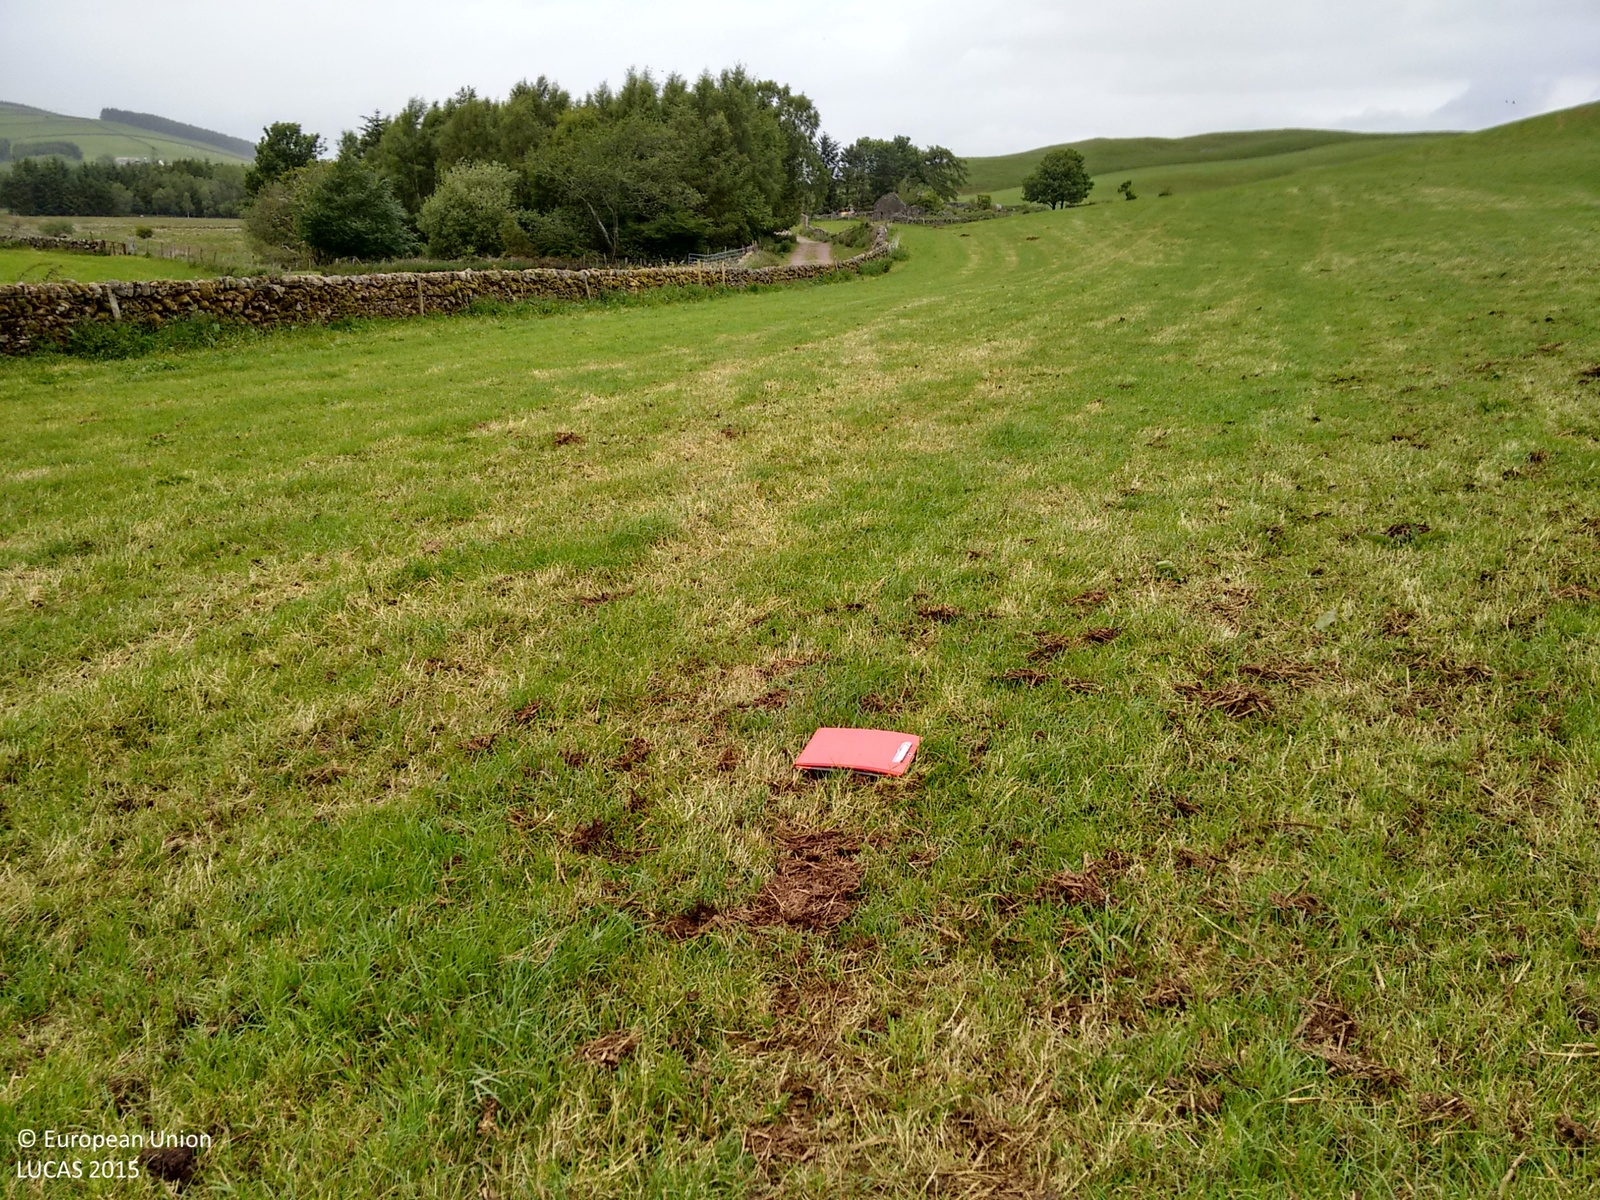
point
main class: Grassland
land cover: Grassland without tree/shrub cover
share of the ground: > 75 %
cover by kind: herbaceous plants 80 %, unconsolidated bare surface 20 %
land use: Agriculture (excluding fallow land and kitchen gardens)
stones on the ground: < 10 %
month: June
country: GB
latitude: 55.1677
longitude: -3.7588
